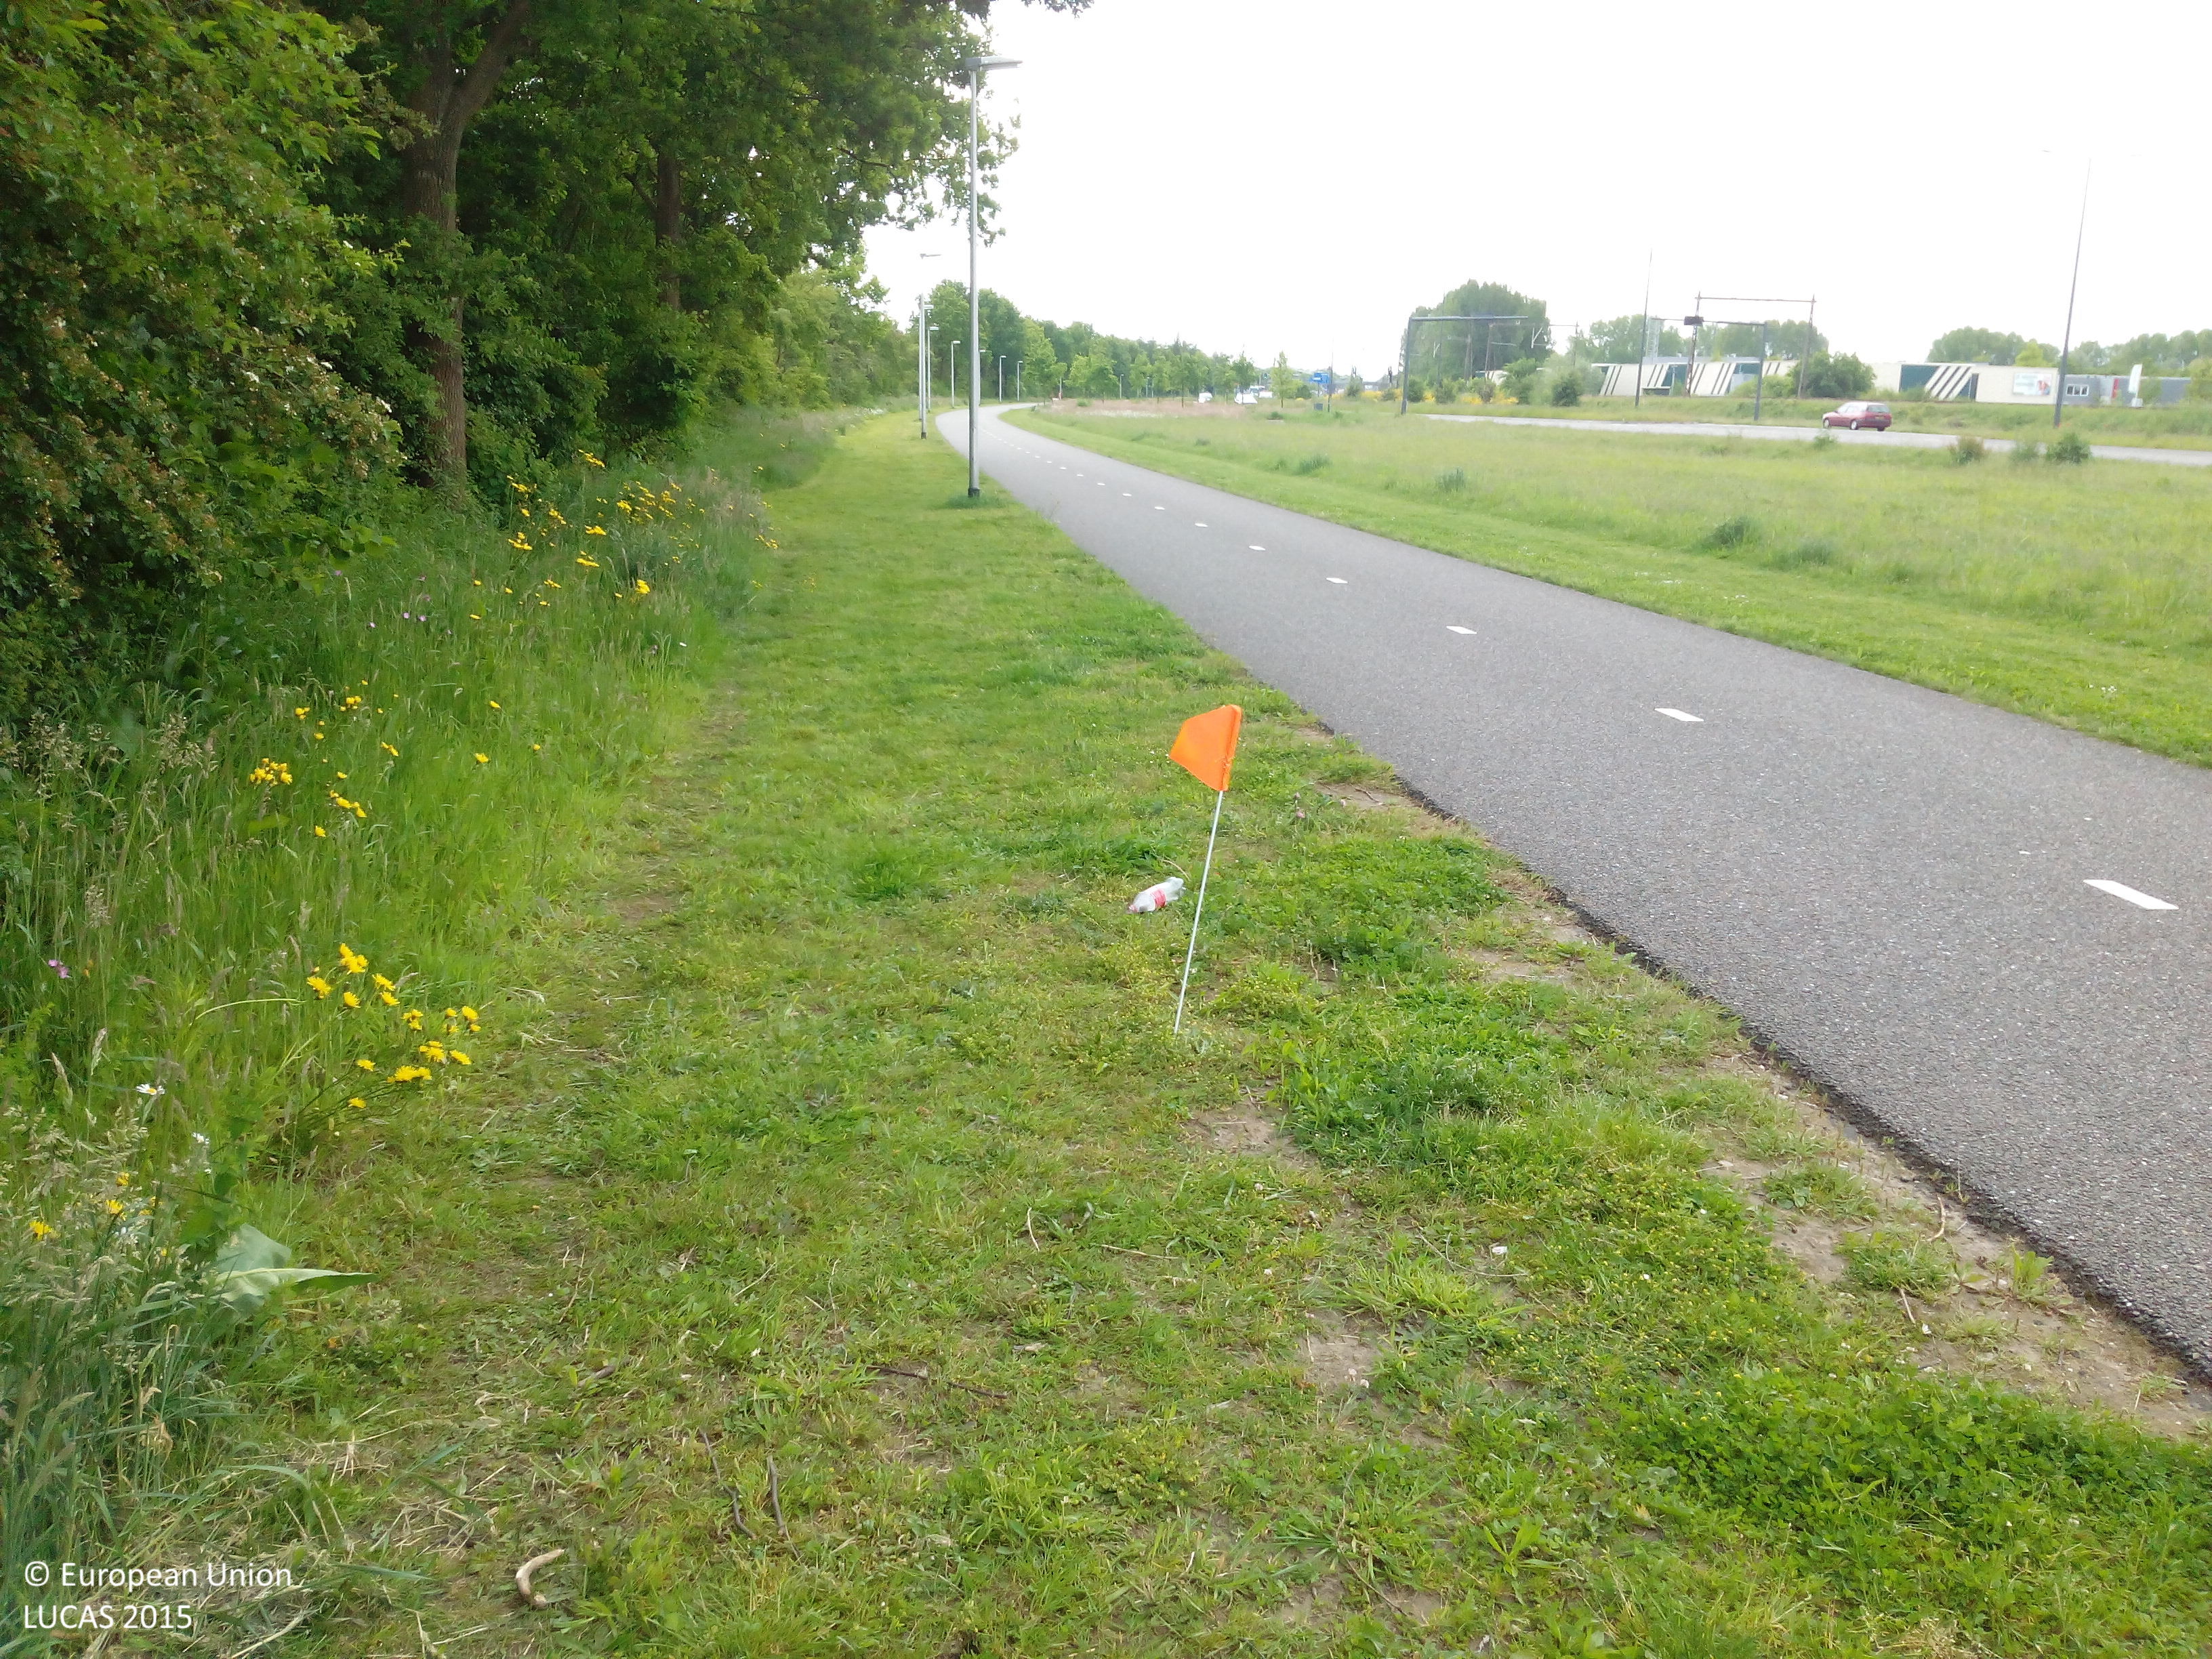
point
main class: Grassland
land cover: Grassland without tree/shrub cover
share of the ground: > 75 %
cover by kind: herbaceous plants 100 %
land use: Road transport
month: May
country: NL
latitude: 52.2449
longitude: 6.2061
